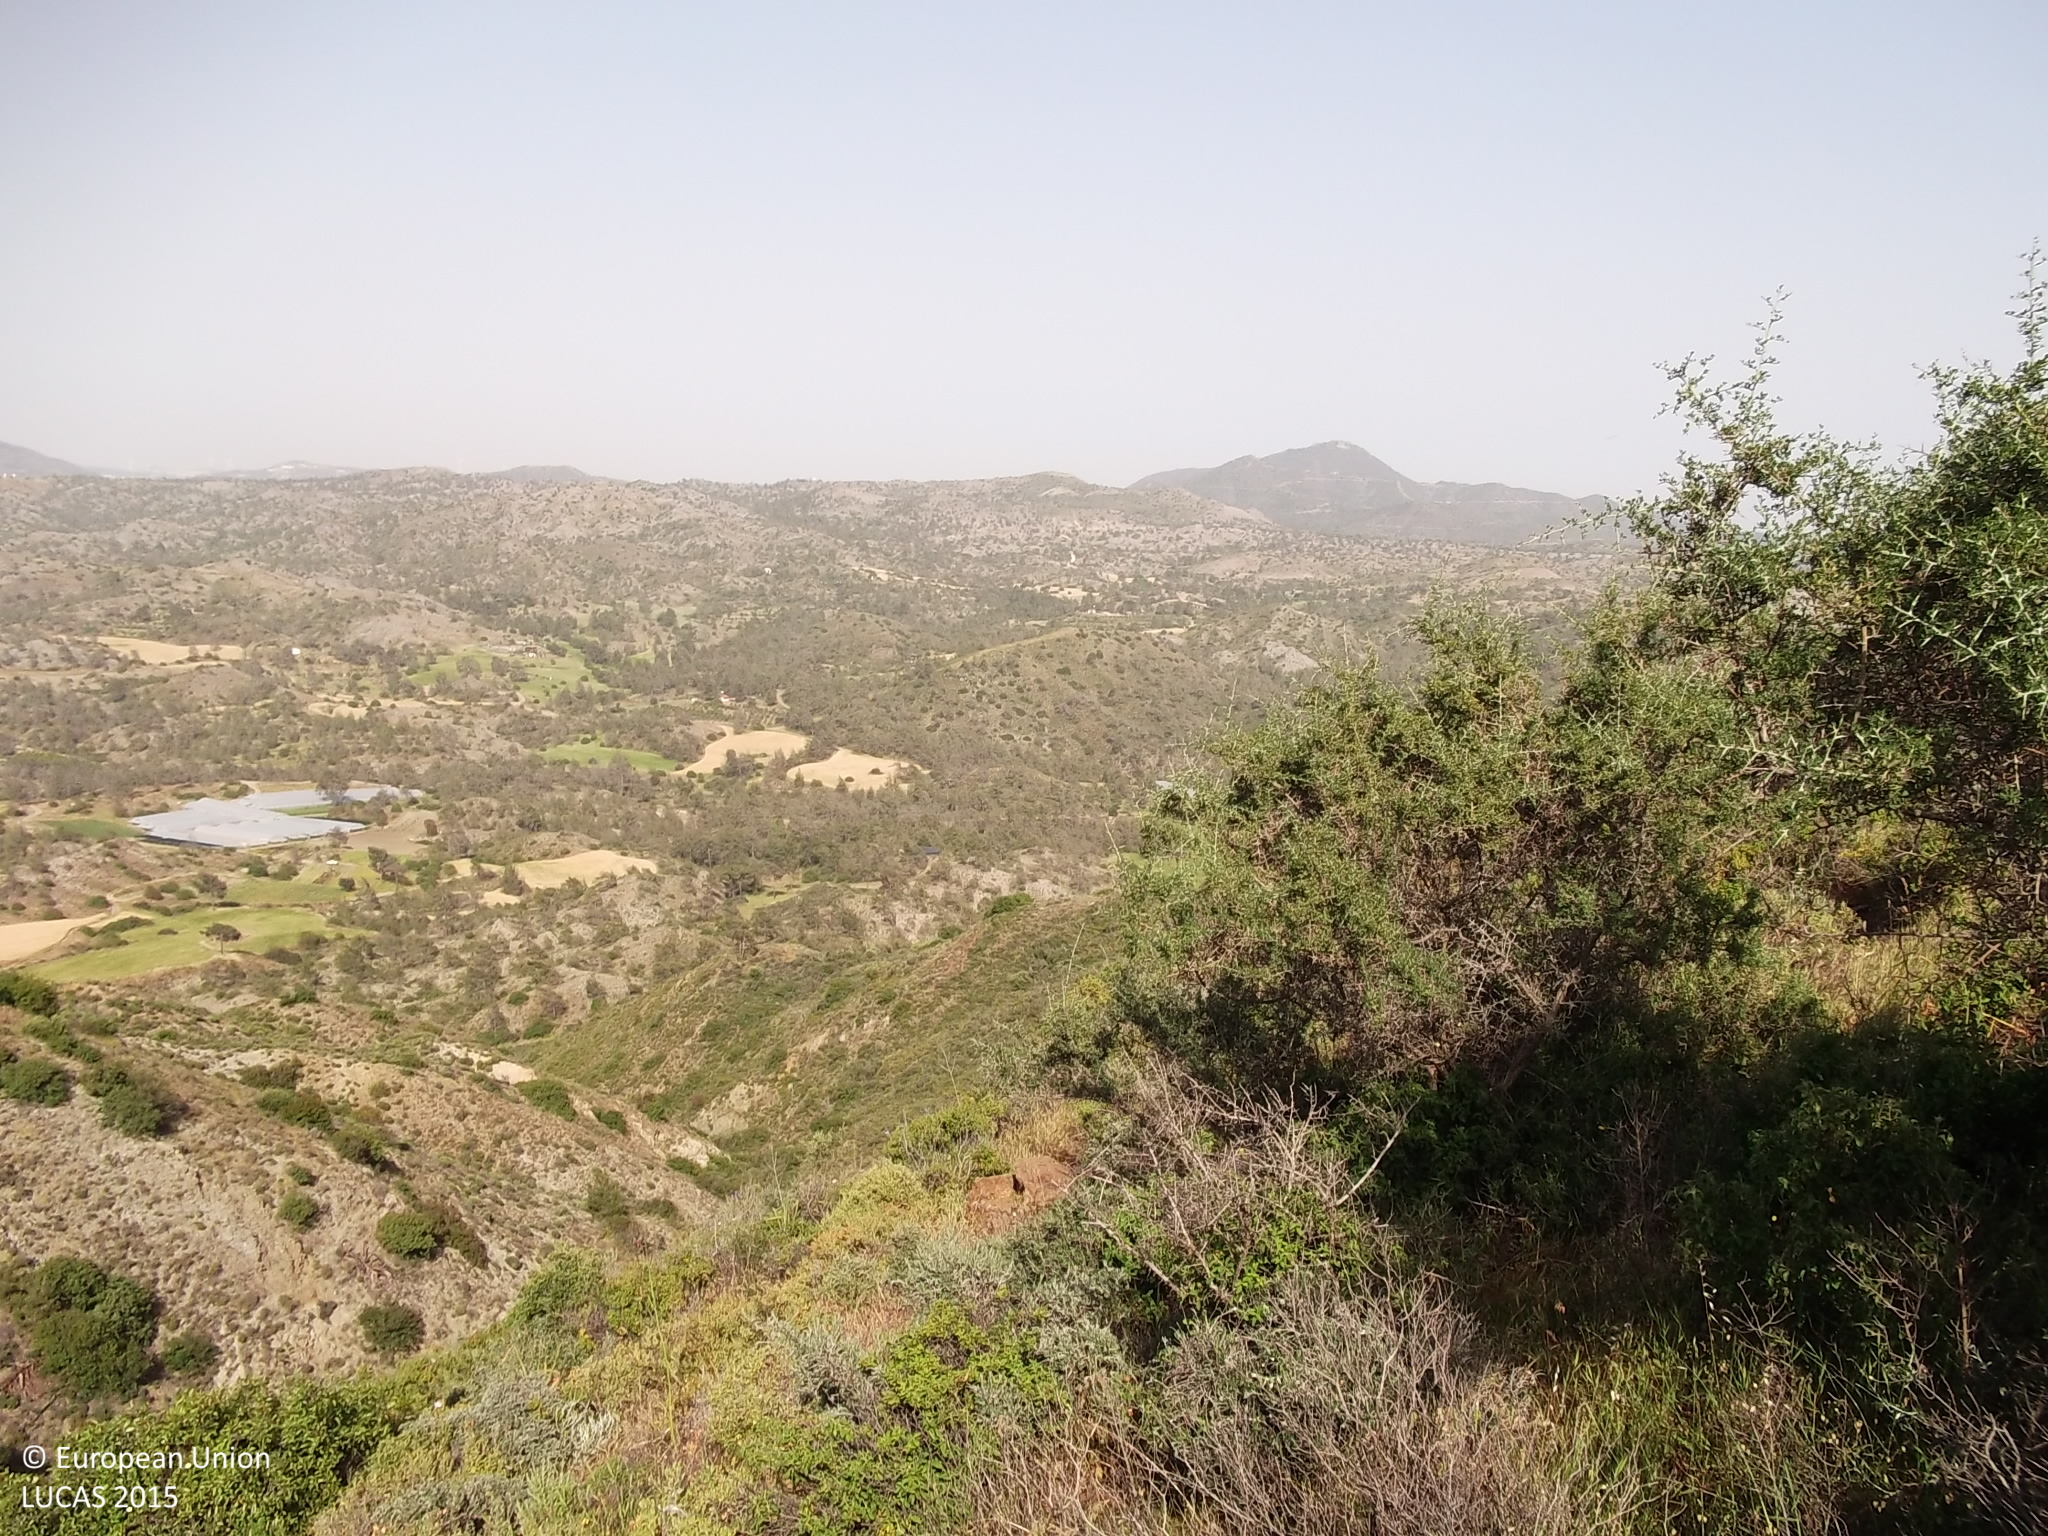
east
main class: Shrubland
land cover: Shrubland without tree cover
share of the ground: > 75 %
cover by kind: shrubs 85 %, herbaceous plants 10 %, unconsolidated bare surface 5 %
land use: Semi-natural and natural areas not in use
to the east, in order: Shrubland without tree cover
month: April
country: CY
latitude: 34.8917
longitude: 33.3490
